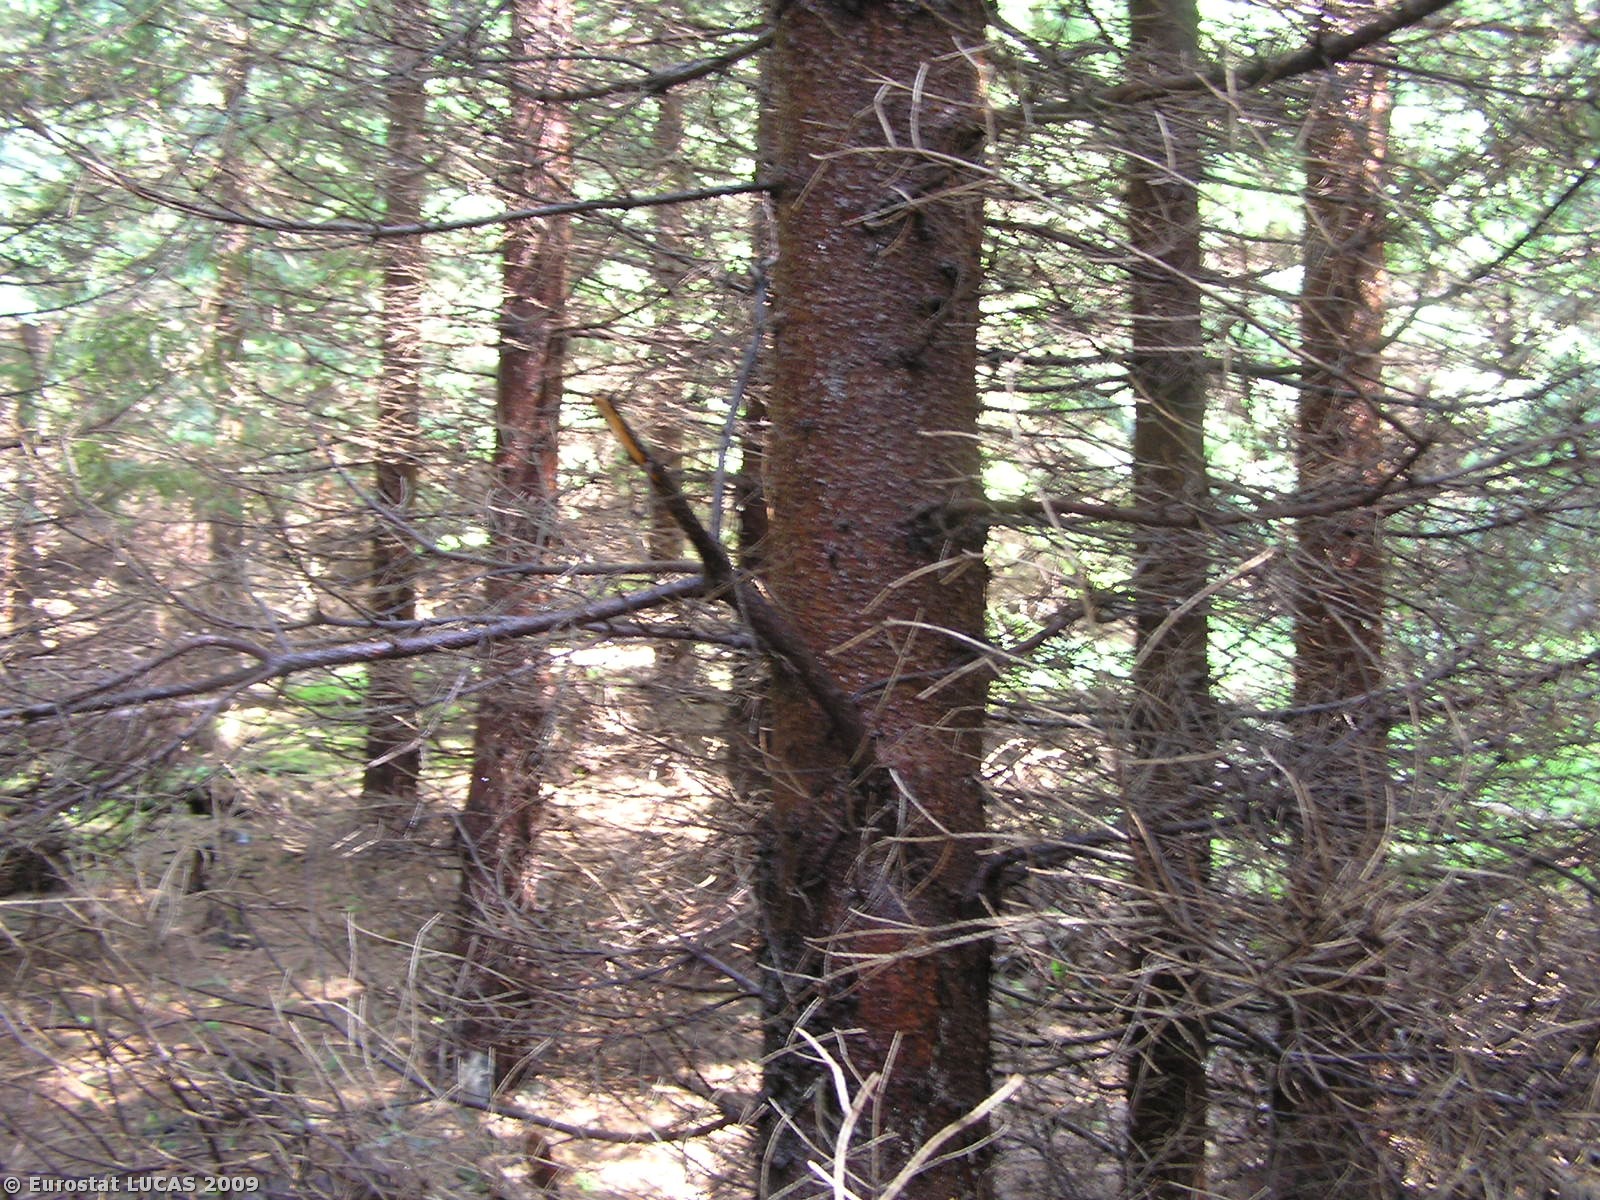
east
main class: Woodland
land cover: Coniferous woodland
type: hemiboreal forest and nemoral coniferous forest and mixed broadleaved-coniferous forest
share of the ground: > 75 %
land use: Forestry
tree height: > 5 m
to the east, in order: Coniferous woodland; Tracks; Coniferous woodland; Tracks; Coniferous woodland
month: June
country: CZ
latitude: 50.2110
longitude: 17.4530
